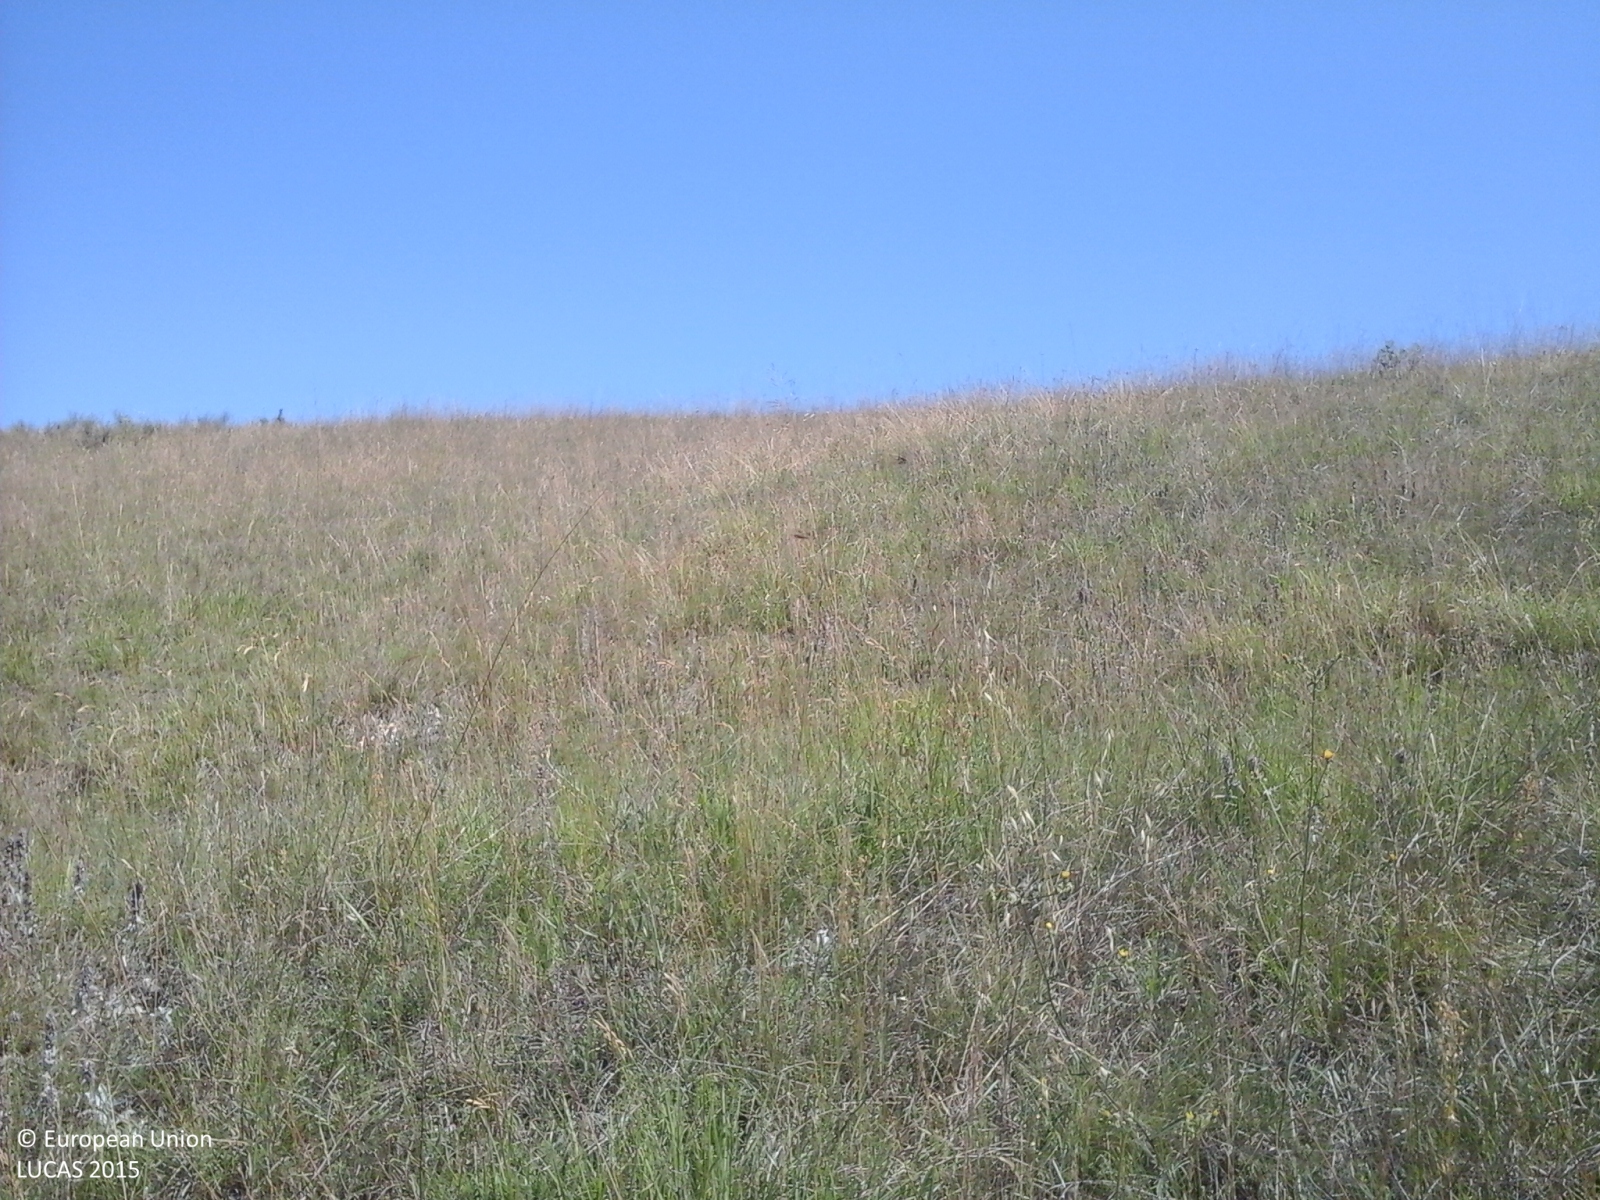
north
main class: Grassland
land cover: Grassland without tree/shrub cover
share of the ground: > 75 %
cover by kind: herbaceous plants 85 %, consolidated bare surface 15 %
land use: Semi-natural and natural areas not in use
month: June
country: IT
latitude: 44.5650
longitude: 10.6407
